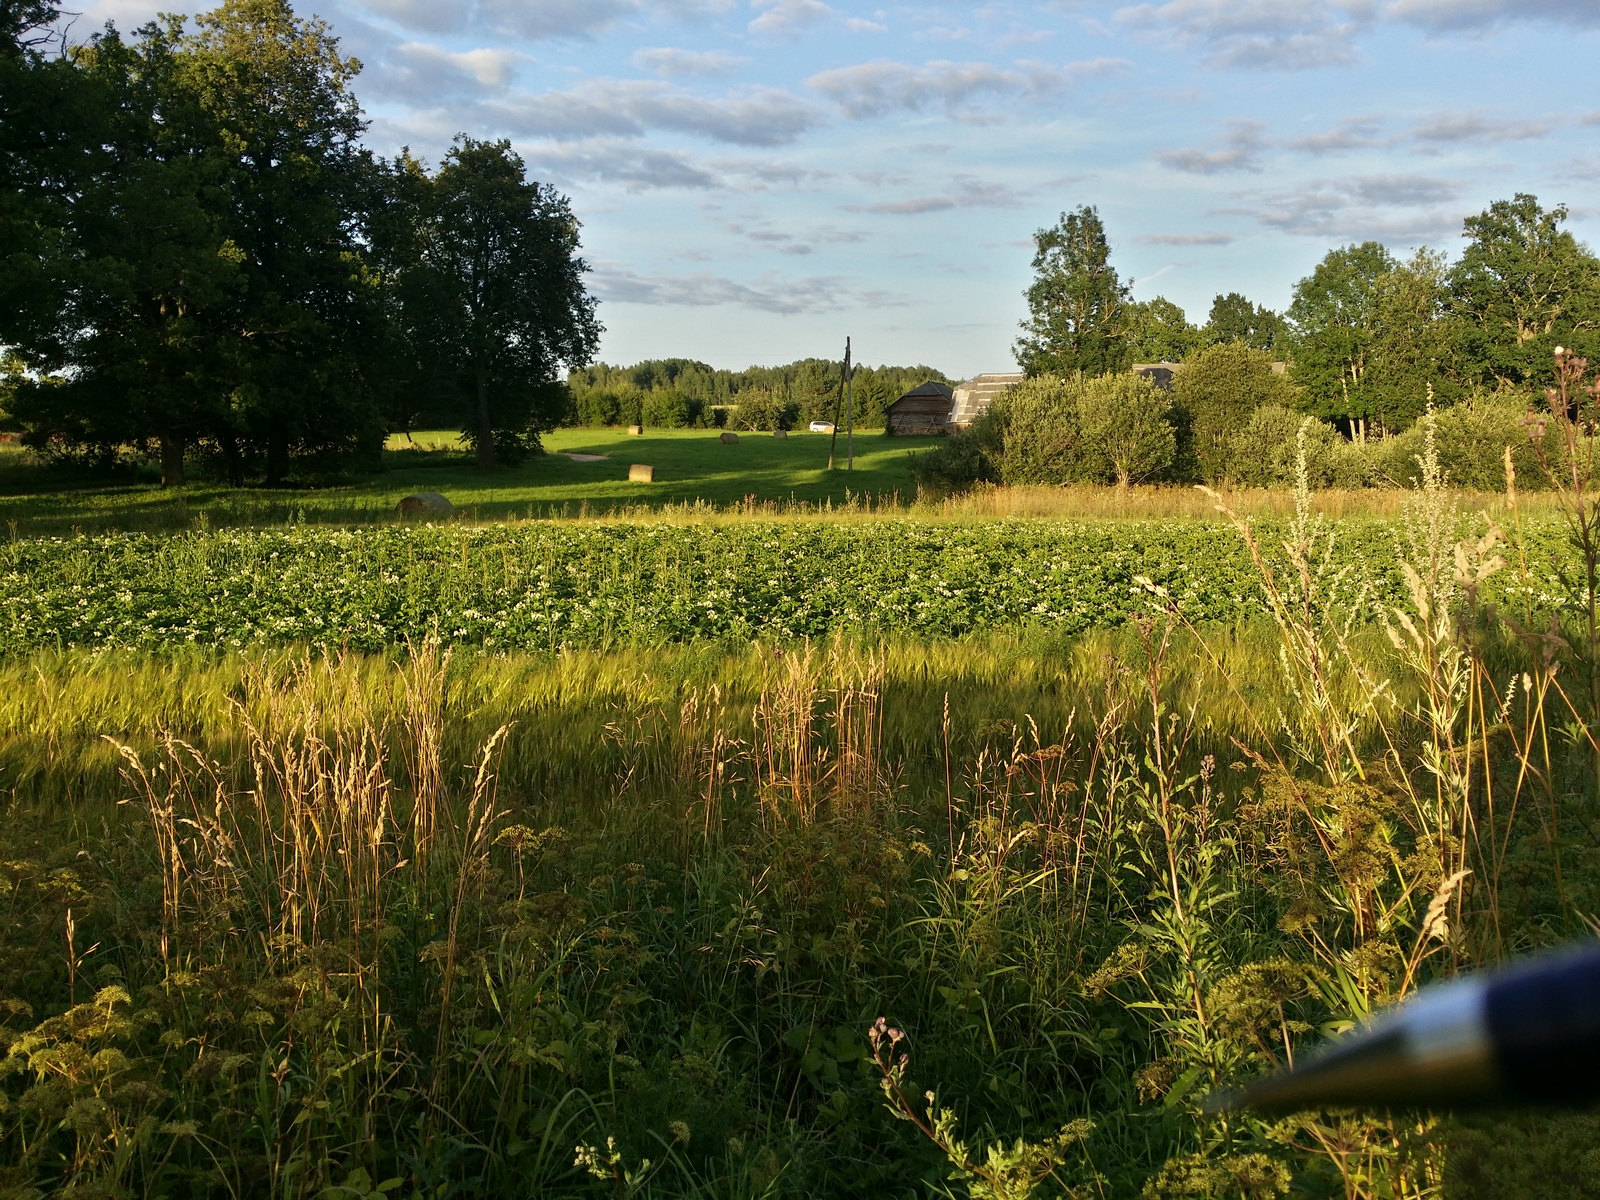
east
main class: Grassland
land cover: Spontaneously vegetated surfaces
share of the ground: > 75 %
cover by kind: herbaceous plants 95 %, shrubs 5 %
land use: Semi-natural and natural areas not in use
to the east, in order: Spontaneously vegetated surfaces; Barley; Potatoes; Strawberries; Spontaneously vegetated surfaces; Grassland without tree/shrub cover; Electric lines; Grassland without tree/shrub cover; Tracks; Broadleaved woodland; Common wheat
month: July
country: LV
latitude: 57.2970
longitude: 26.6607
